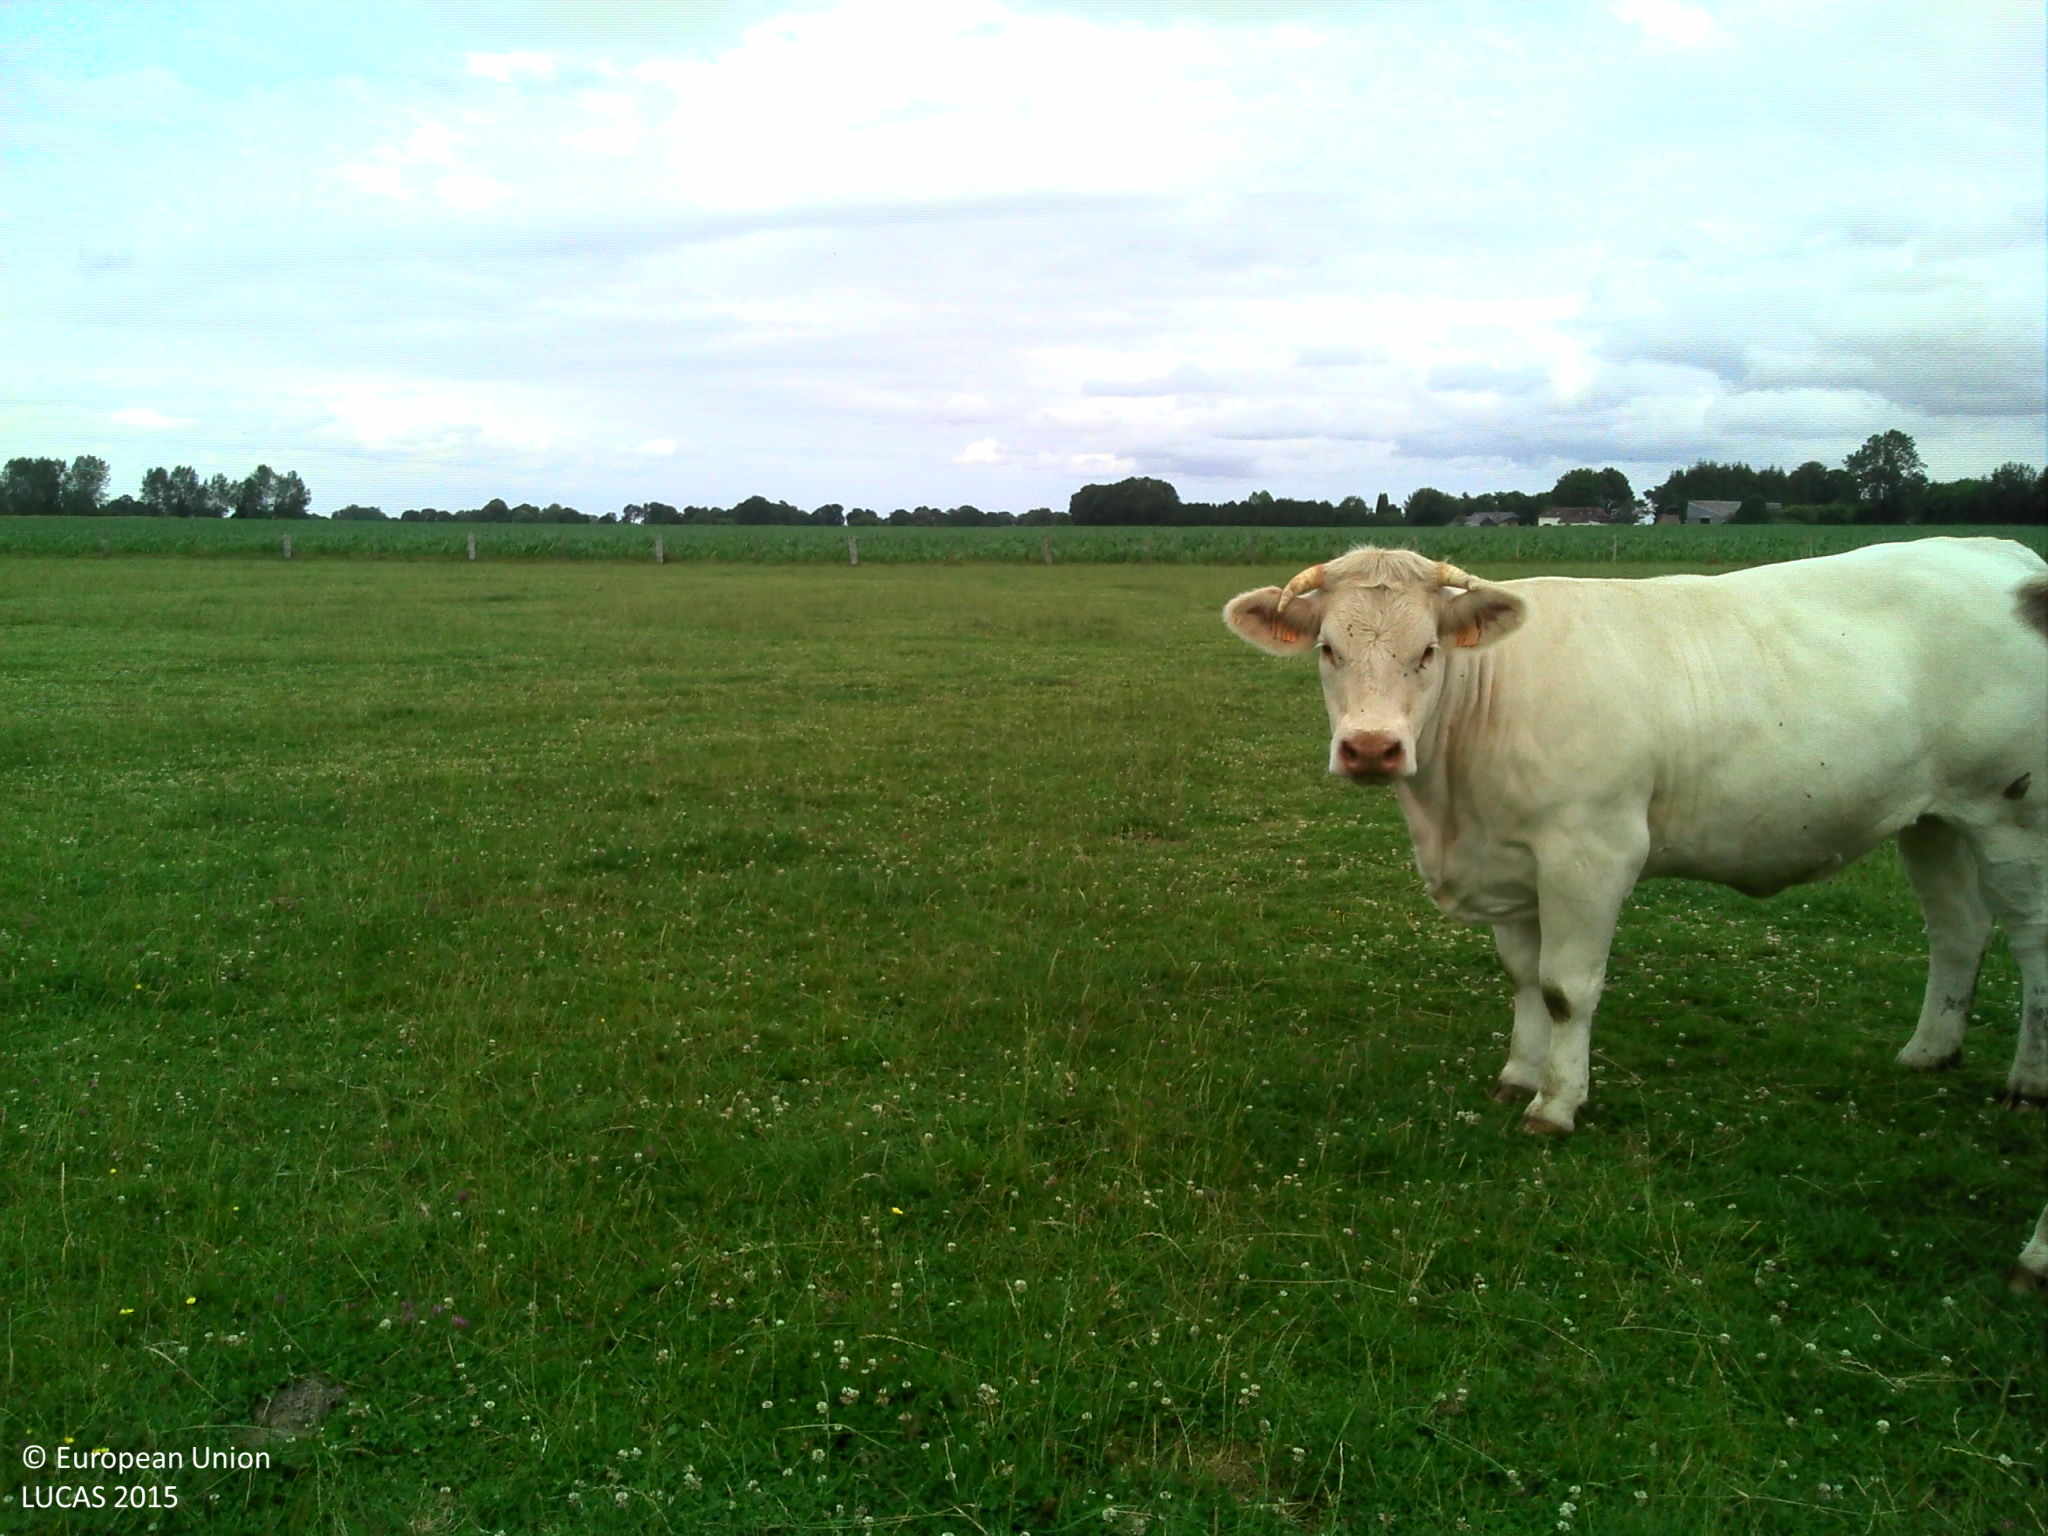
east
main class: Grassland
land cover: Grassland without tree/shrub cover
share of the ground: > 75 %
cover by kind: herbaceous plants 100 %
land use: Agriculture (excluding fallow land and kitchen gardens)
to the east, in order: Grassland without tree/shrub cover; Fences; Grass margins; Maize
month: July
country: FR
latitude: 49.3573
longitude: 0.3484
